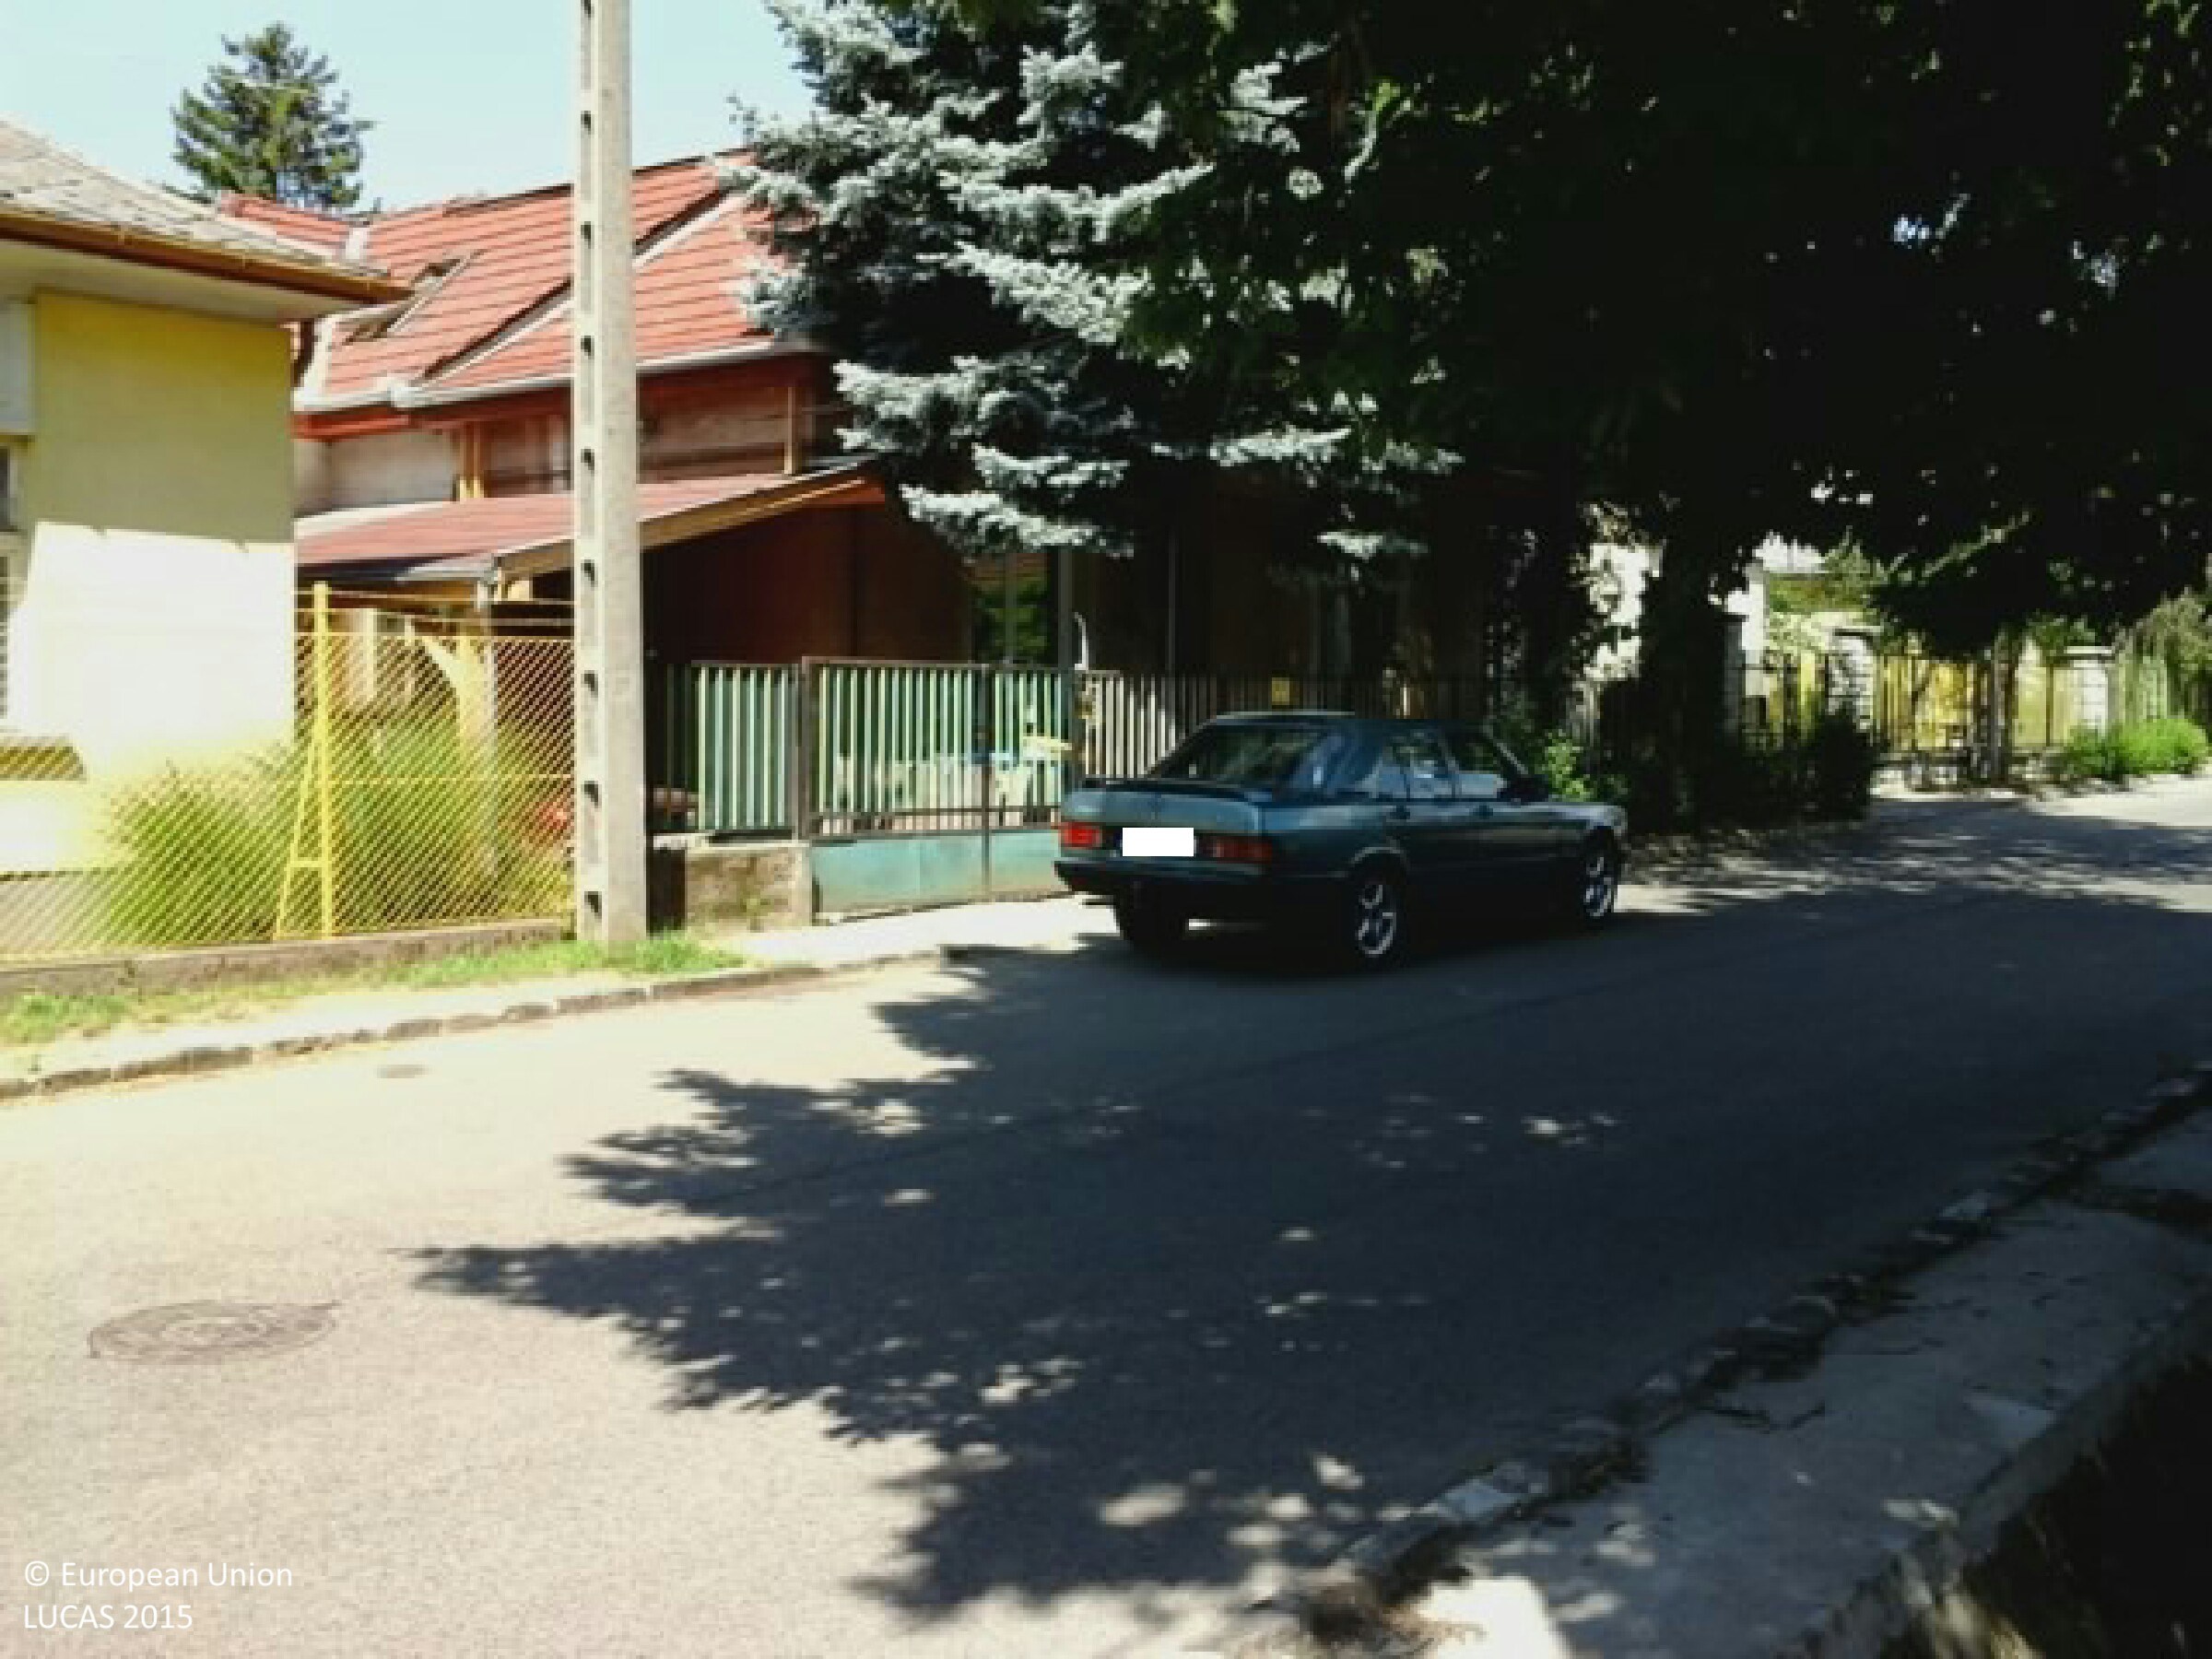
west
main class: Woodland
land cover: Broadleaved woodland
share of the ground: > 75 %
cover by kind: broadleaved forest trees 95 %, coniferous forest trees 5 %
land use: Community services
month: June
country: HU
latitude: 47.4881
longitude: 19.2702
